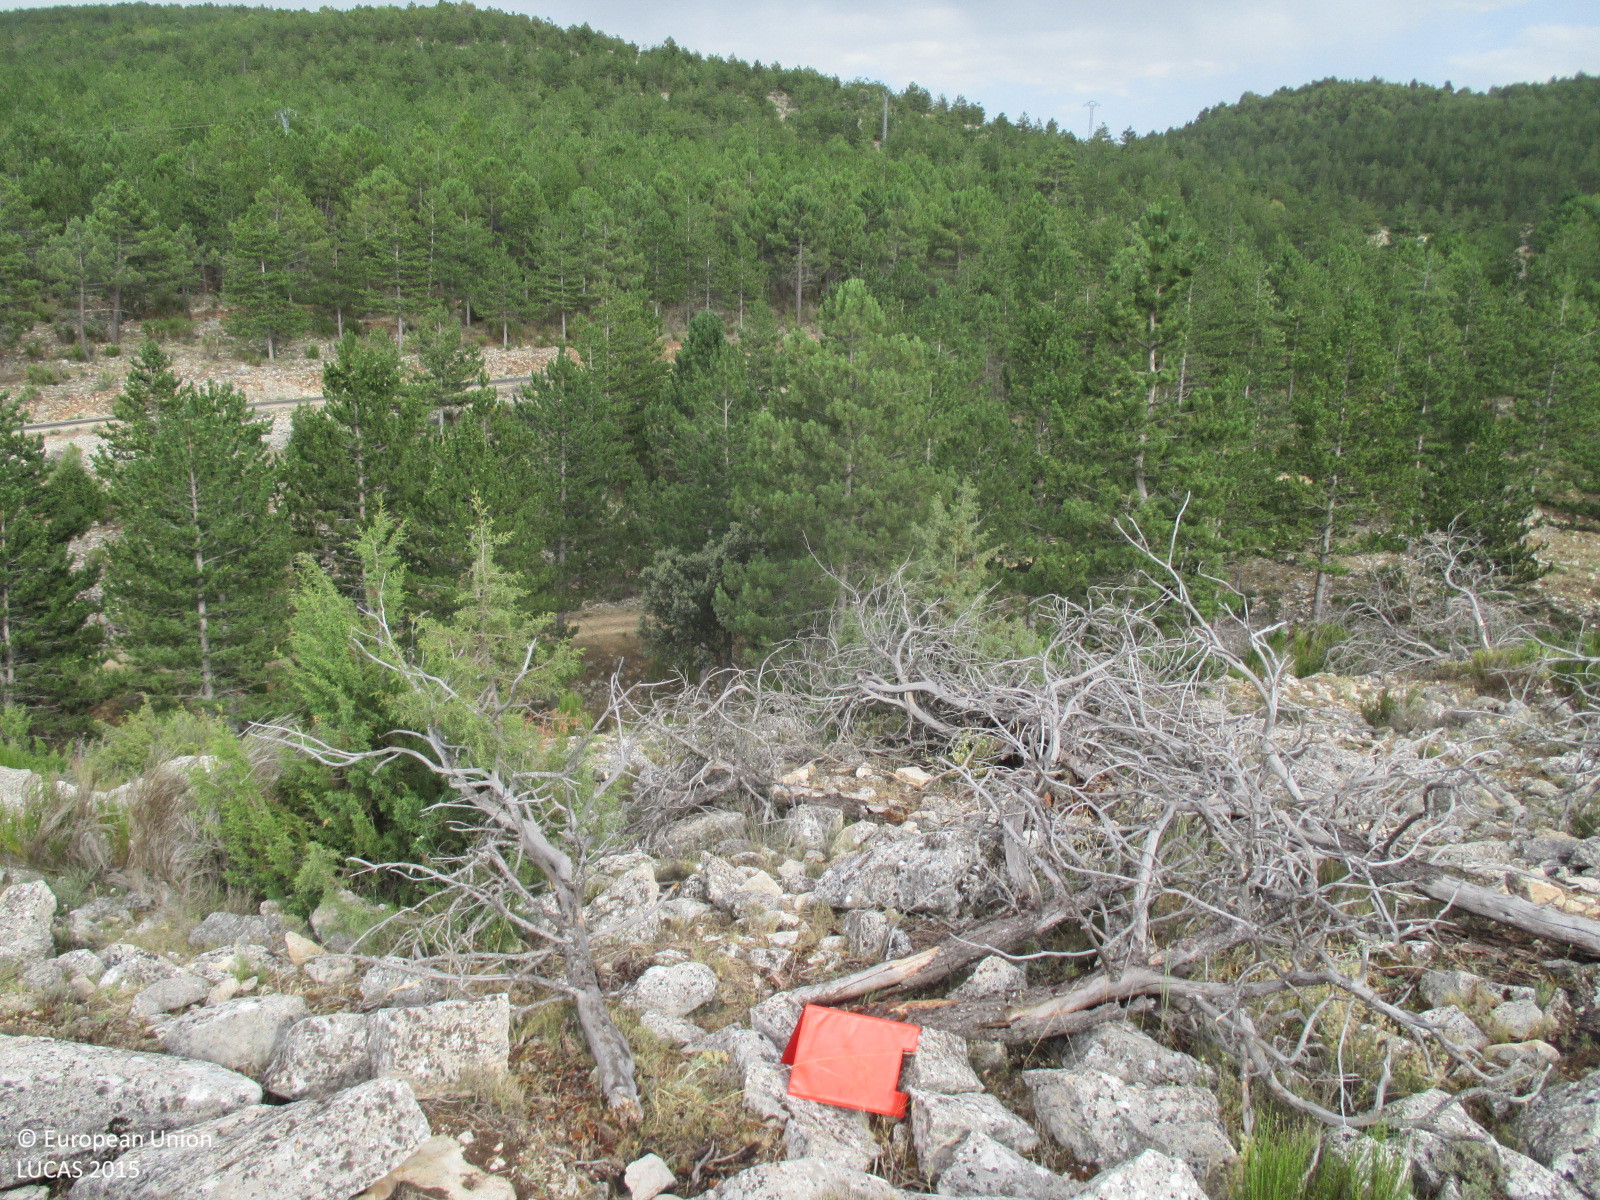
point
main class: Shrubland
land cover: Shrubland with sparse tree cover
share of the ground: 50 - 75 %
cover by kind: shrubs 60 %, herbaceous plants 35 %, coniferous forest trees 5 %
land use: Semi-natural and natural areas not in use
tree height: < 5 m
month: July
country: ES
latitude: 38.1571
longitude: -2.4219
